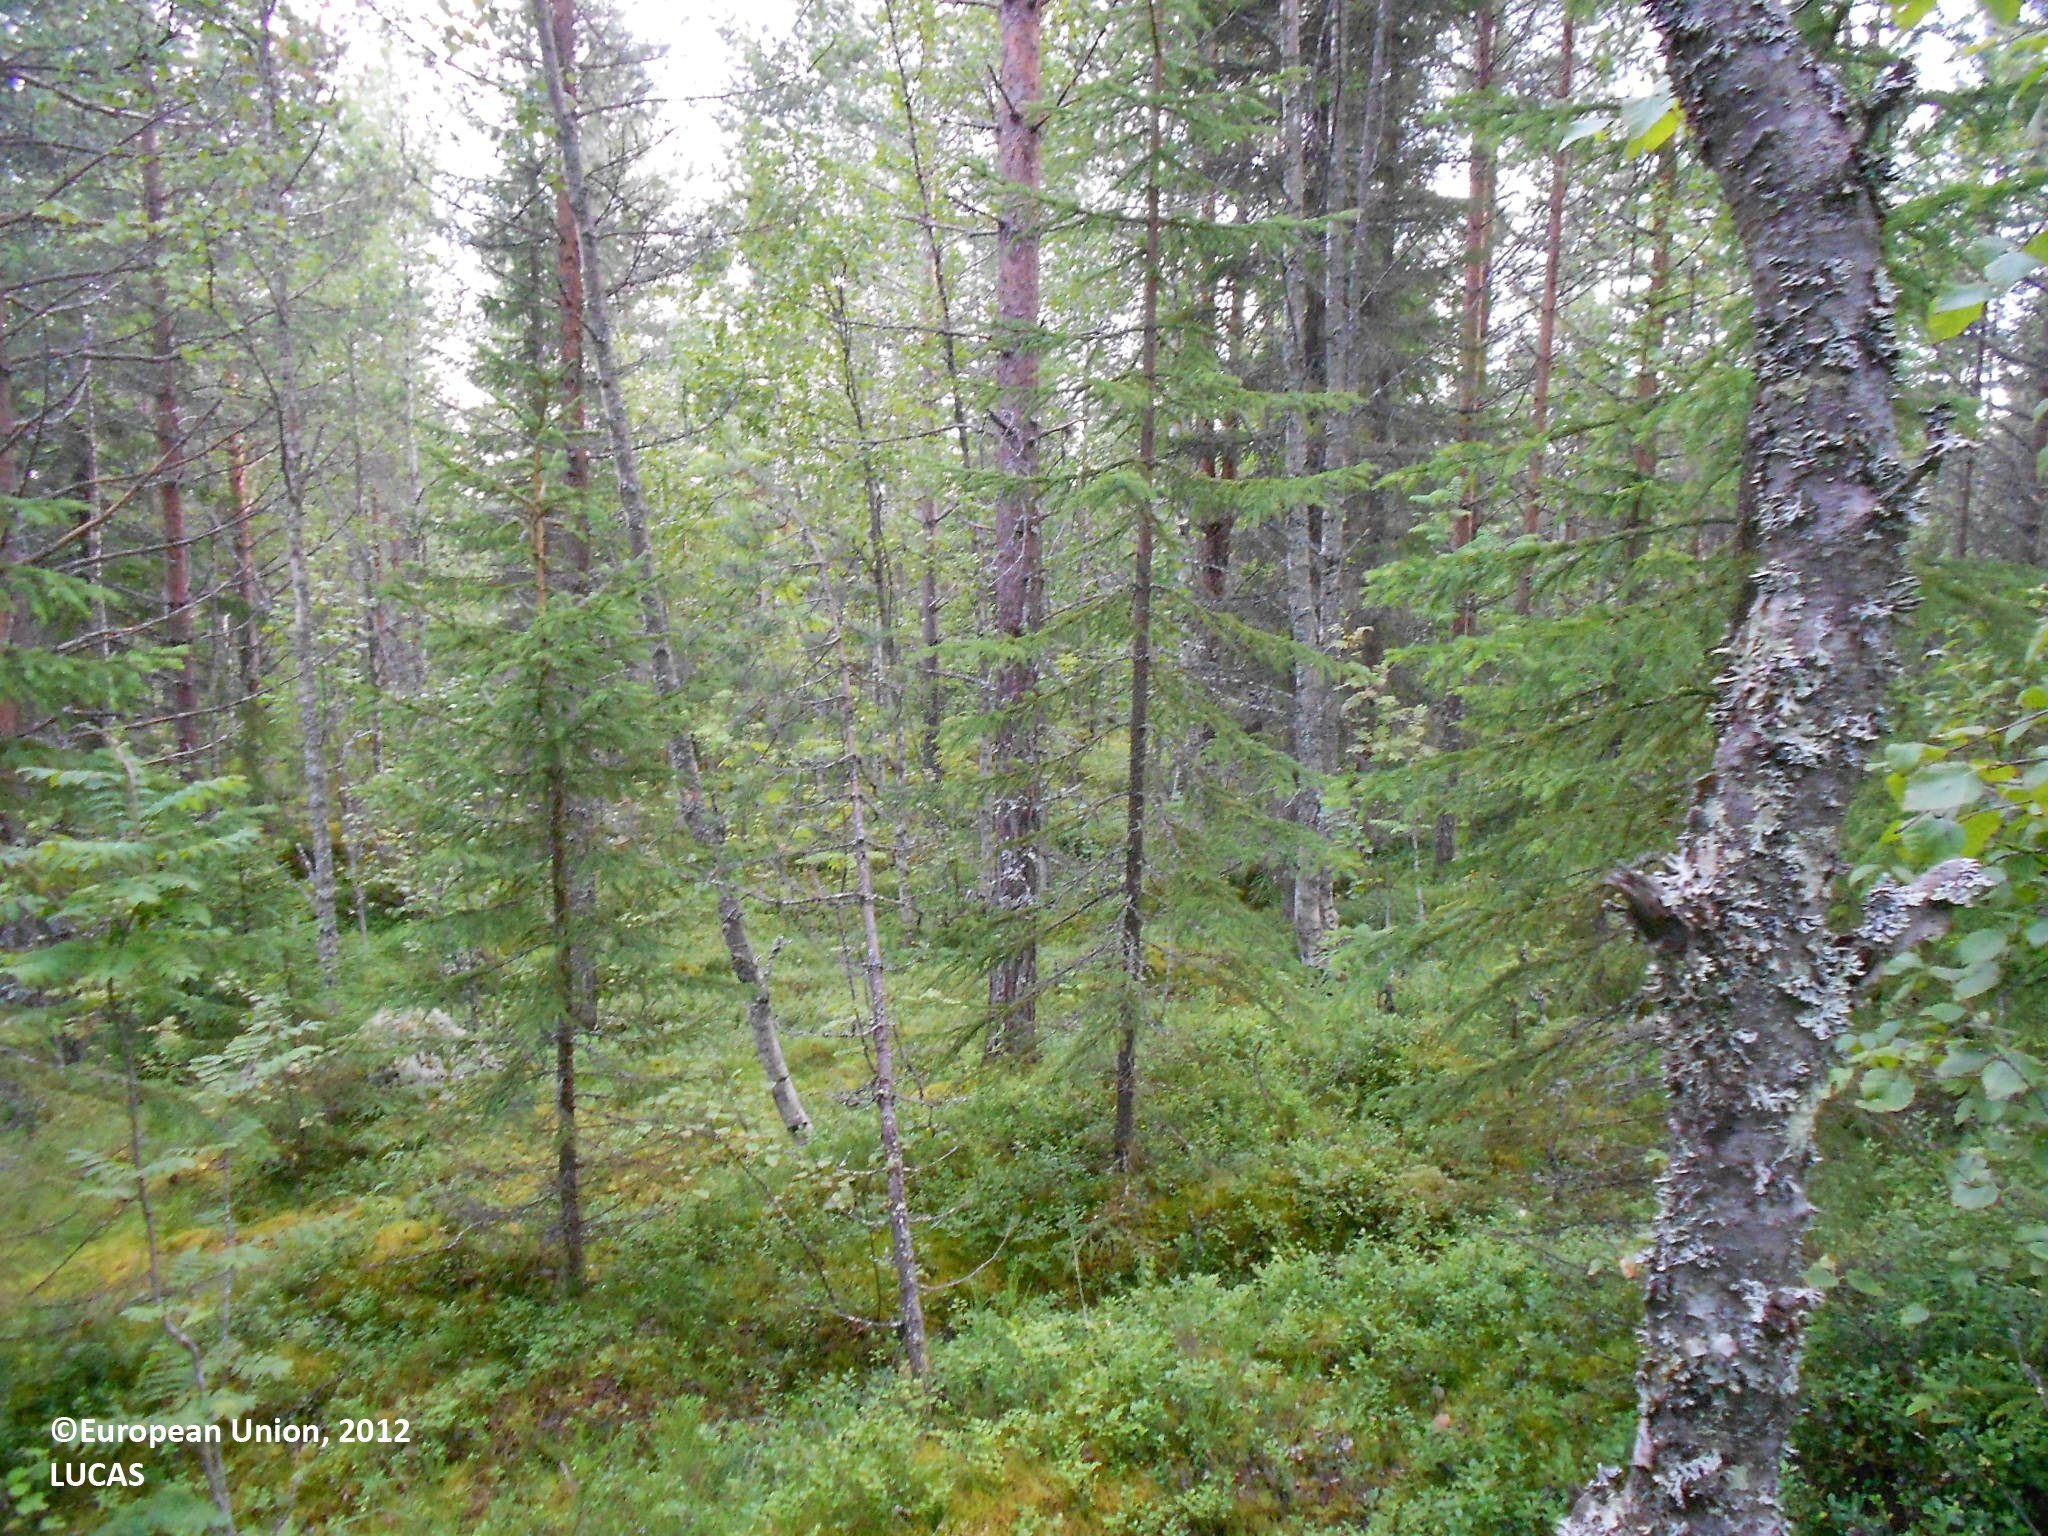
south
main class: Woodland
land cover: Pine dominated coniferous woodland
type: boreal forest
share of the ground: 50 - 75 %
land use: Forestry
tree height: > 5 m
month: August
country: FI
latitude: 63.7711
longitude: 28.4147
